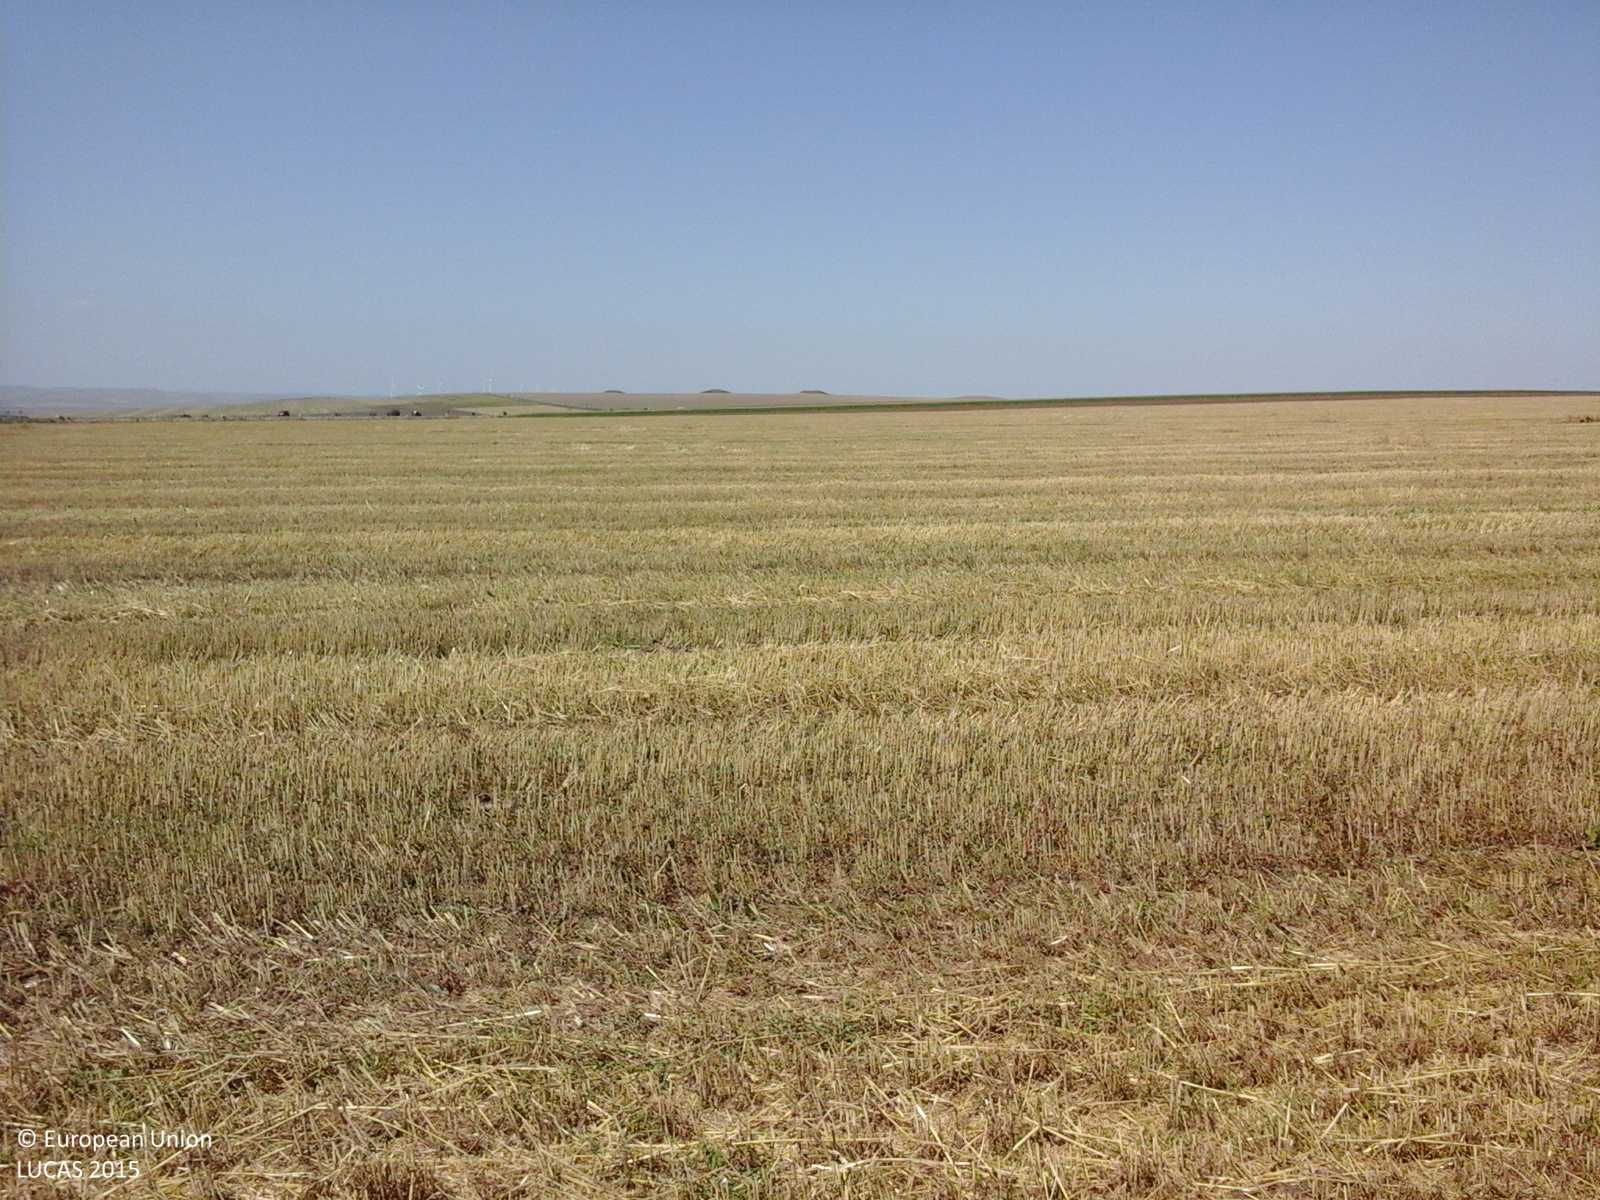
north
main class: Cropland
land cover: Common wheat
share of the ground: > 75 %
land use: Agriculture (excluding fallow land and kitchen gardens)
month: August
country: RO
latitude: 44.6669
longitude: 28.6852
